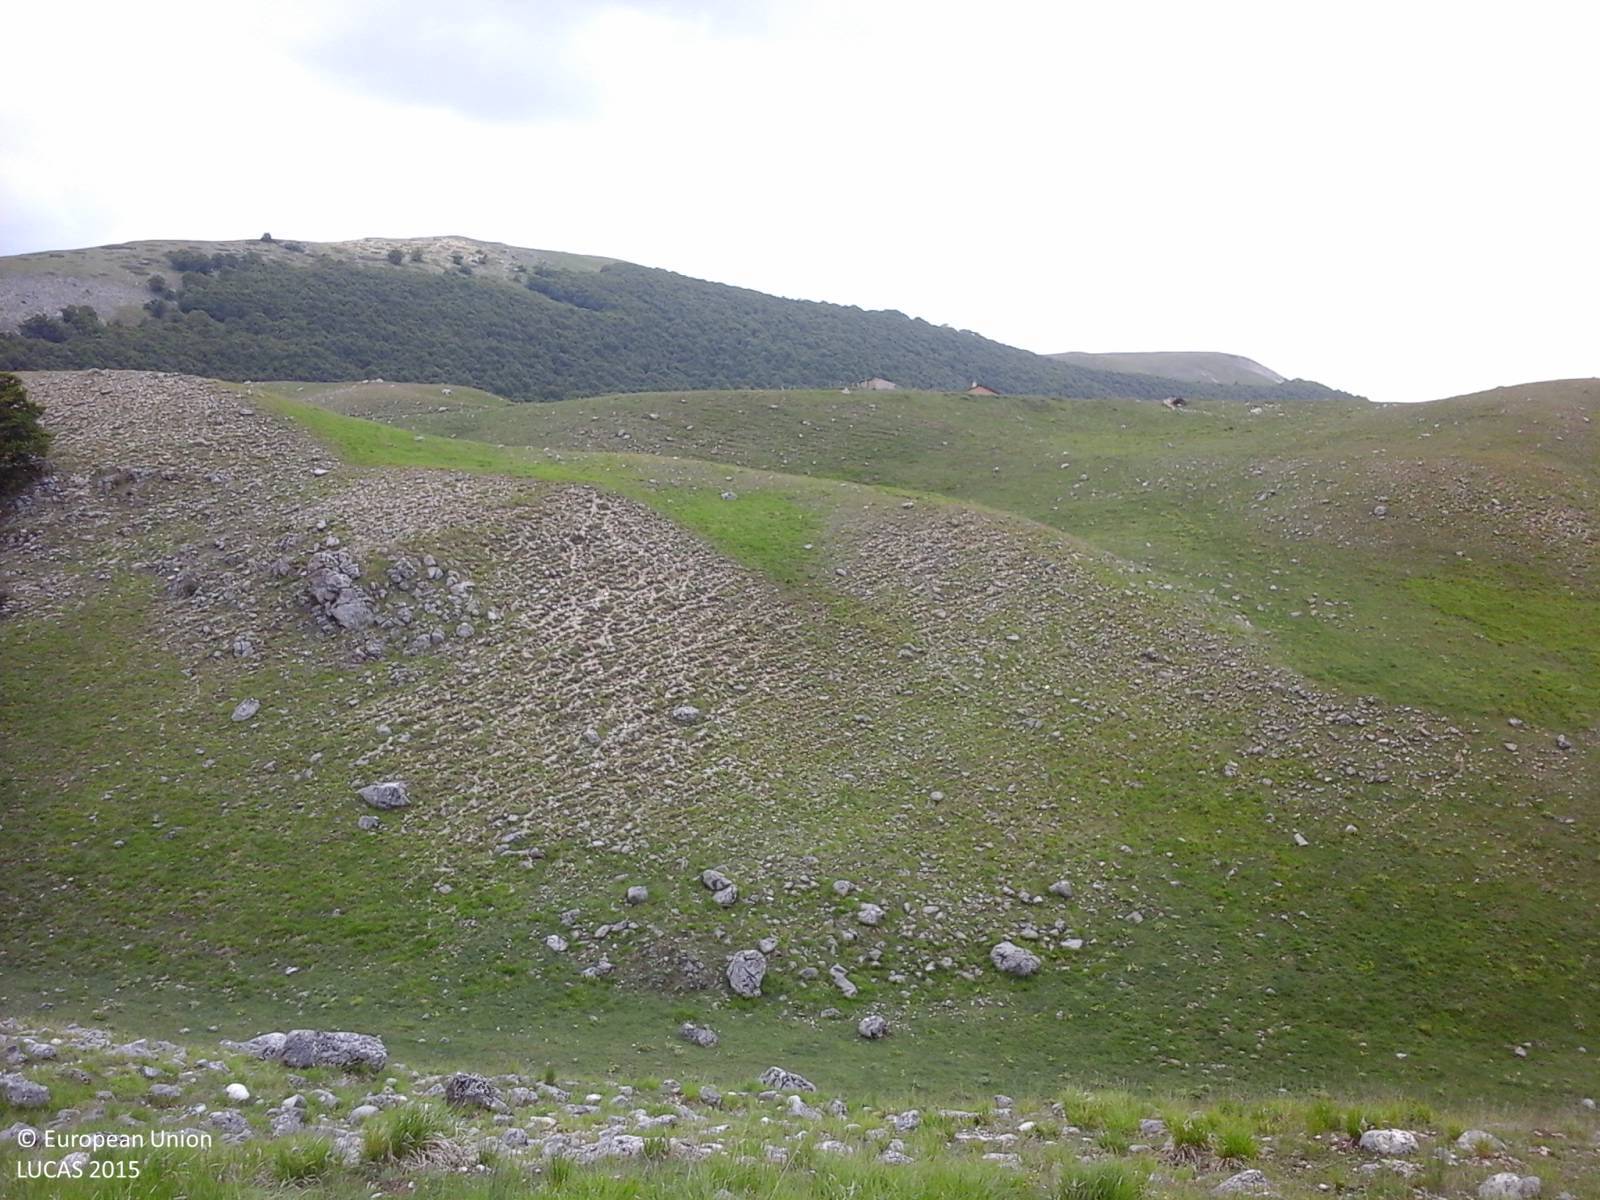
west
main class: Grassland
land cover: Grassland without tree/shrub cover
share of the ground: > 75 %
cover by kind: herbaceous plants 95 %, unconsolidated bare surface 5 %
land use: Agriculture (excluding fallow land and kitchen gardens)
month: June
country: IT
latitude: 41.8526
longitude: 13.9732
